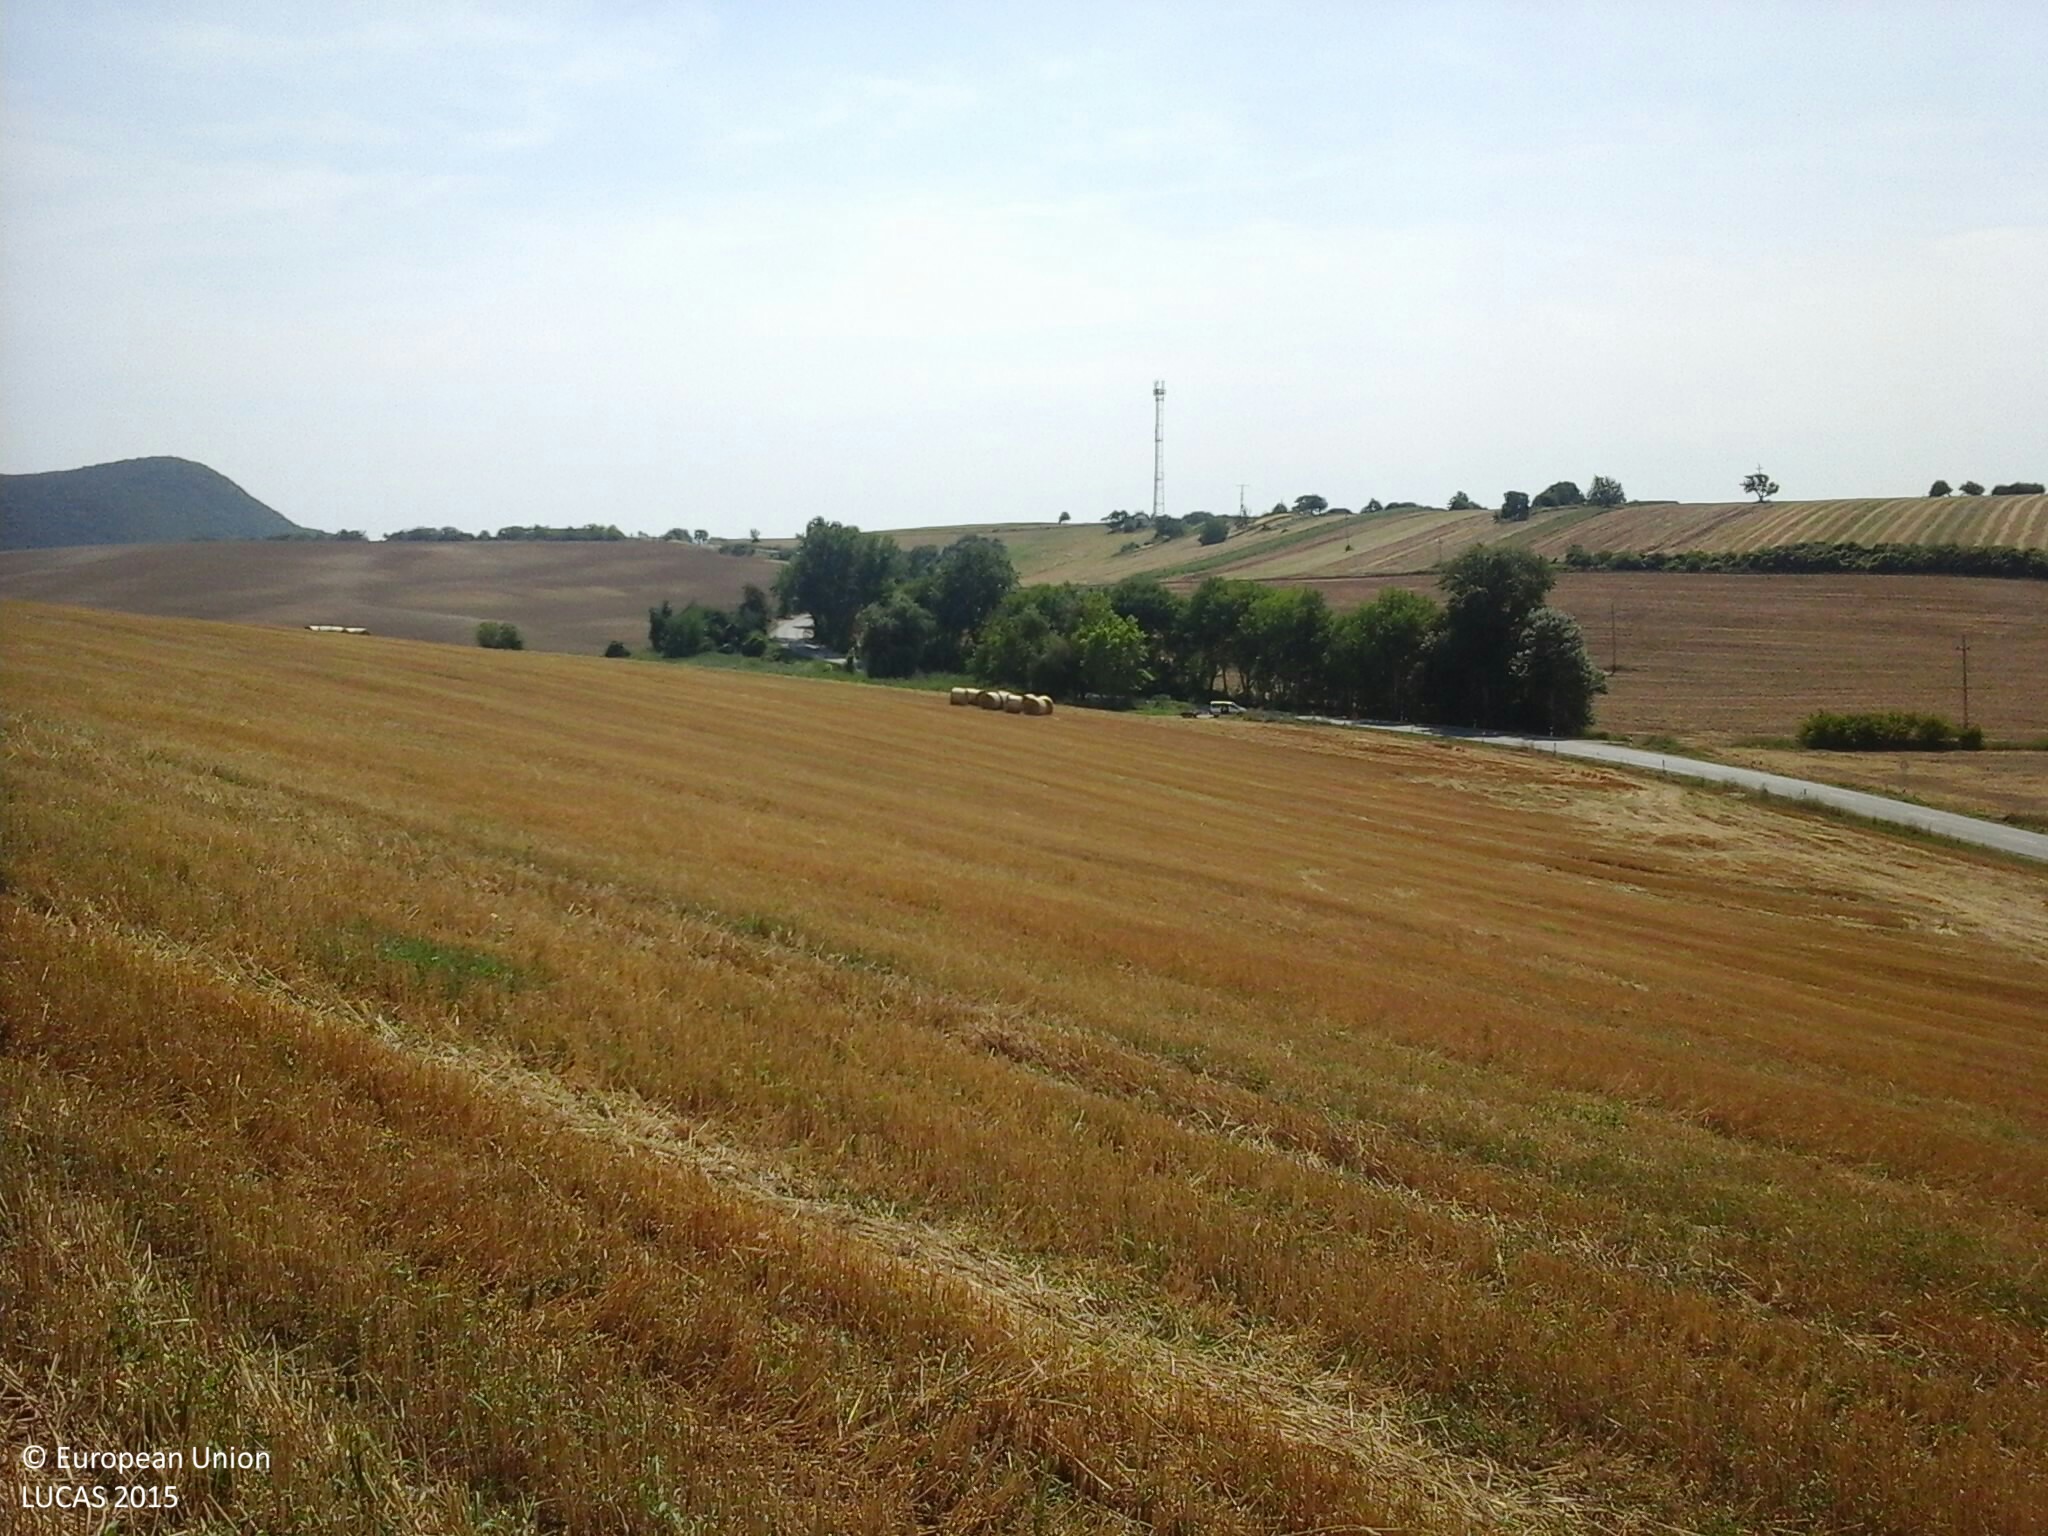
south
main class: Cropland
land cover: Common wheat
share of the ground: > 75 %
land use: Agriculture (excluding fallow land and kitchen gardens)
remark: Harvested field
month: August
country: HU
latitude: 47.6694
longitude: 18.6053
